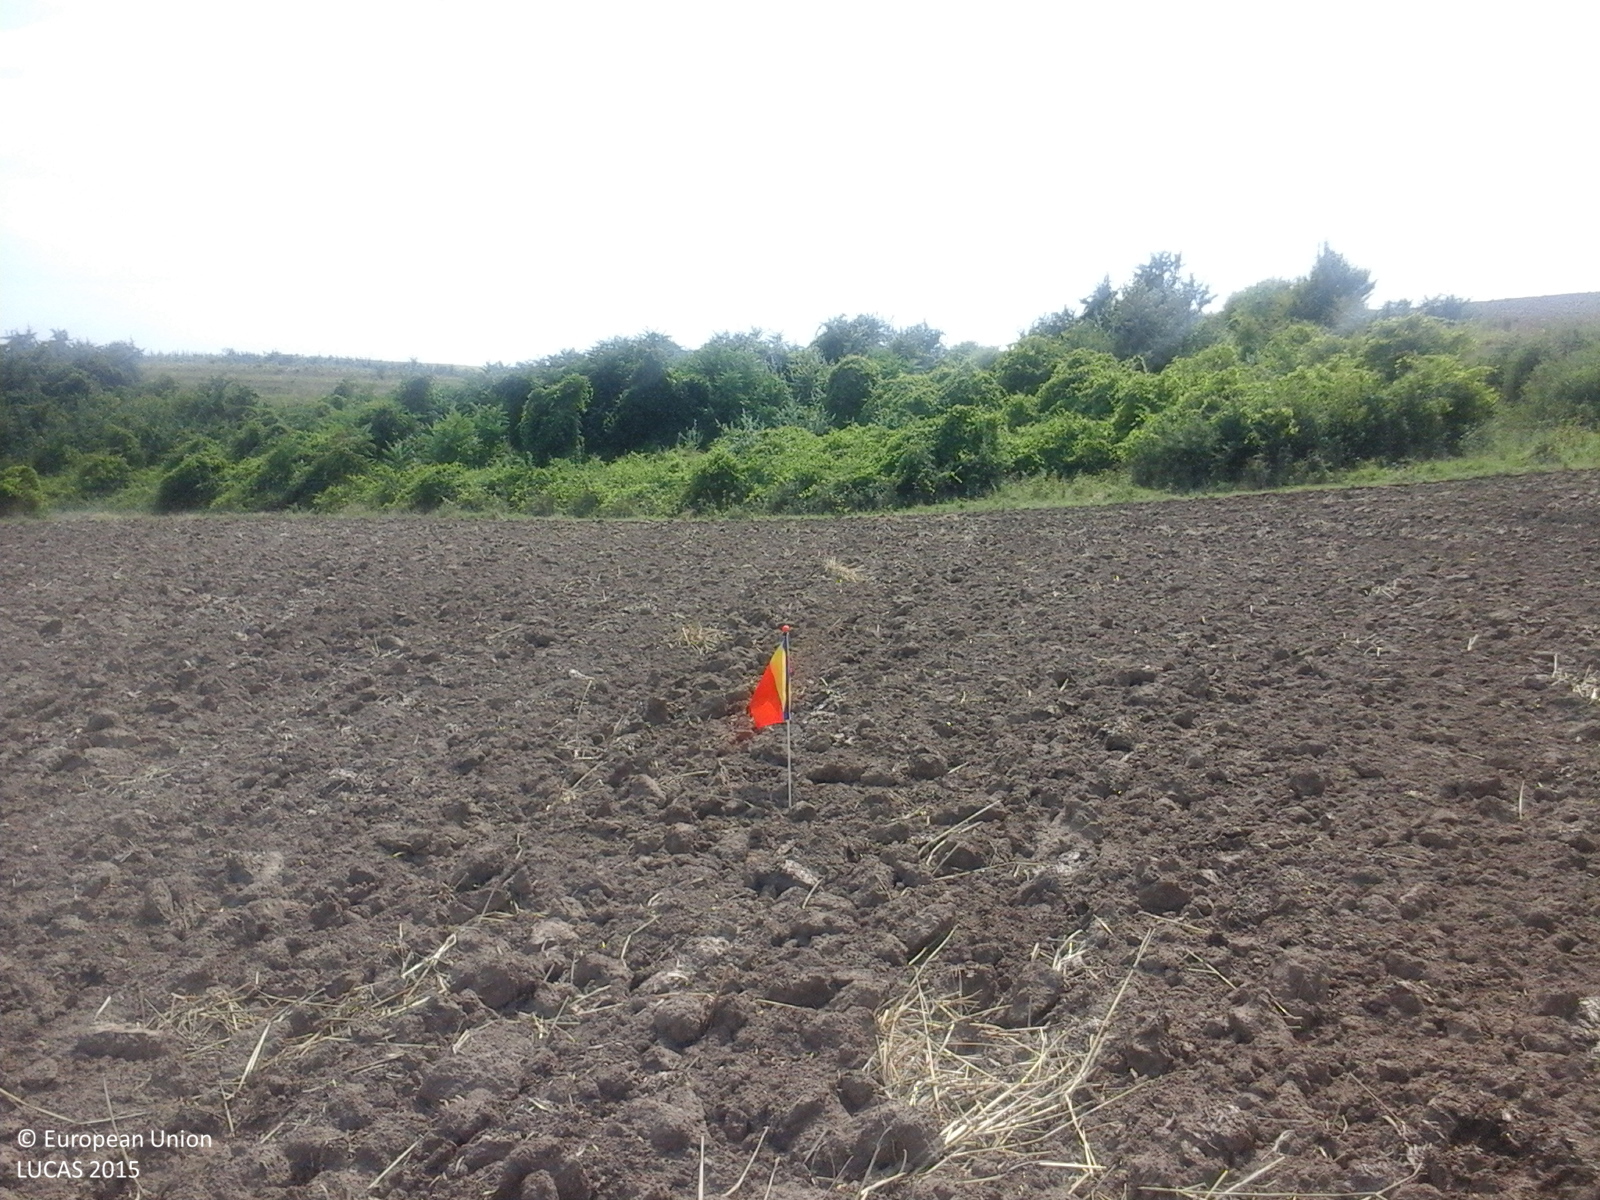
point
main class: Cropland
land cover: Common wheat
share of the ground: < 10 %
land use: Agriculture (excluding fallow land and kitchen gardens)
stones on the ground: < 10 %
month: August
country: RO
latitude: 44.1615
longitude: 27.6888
